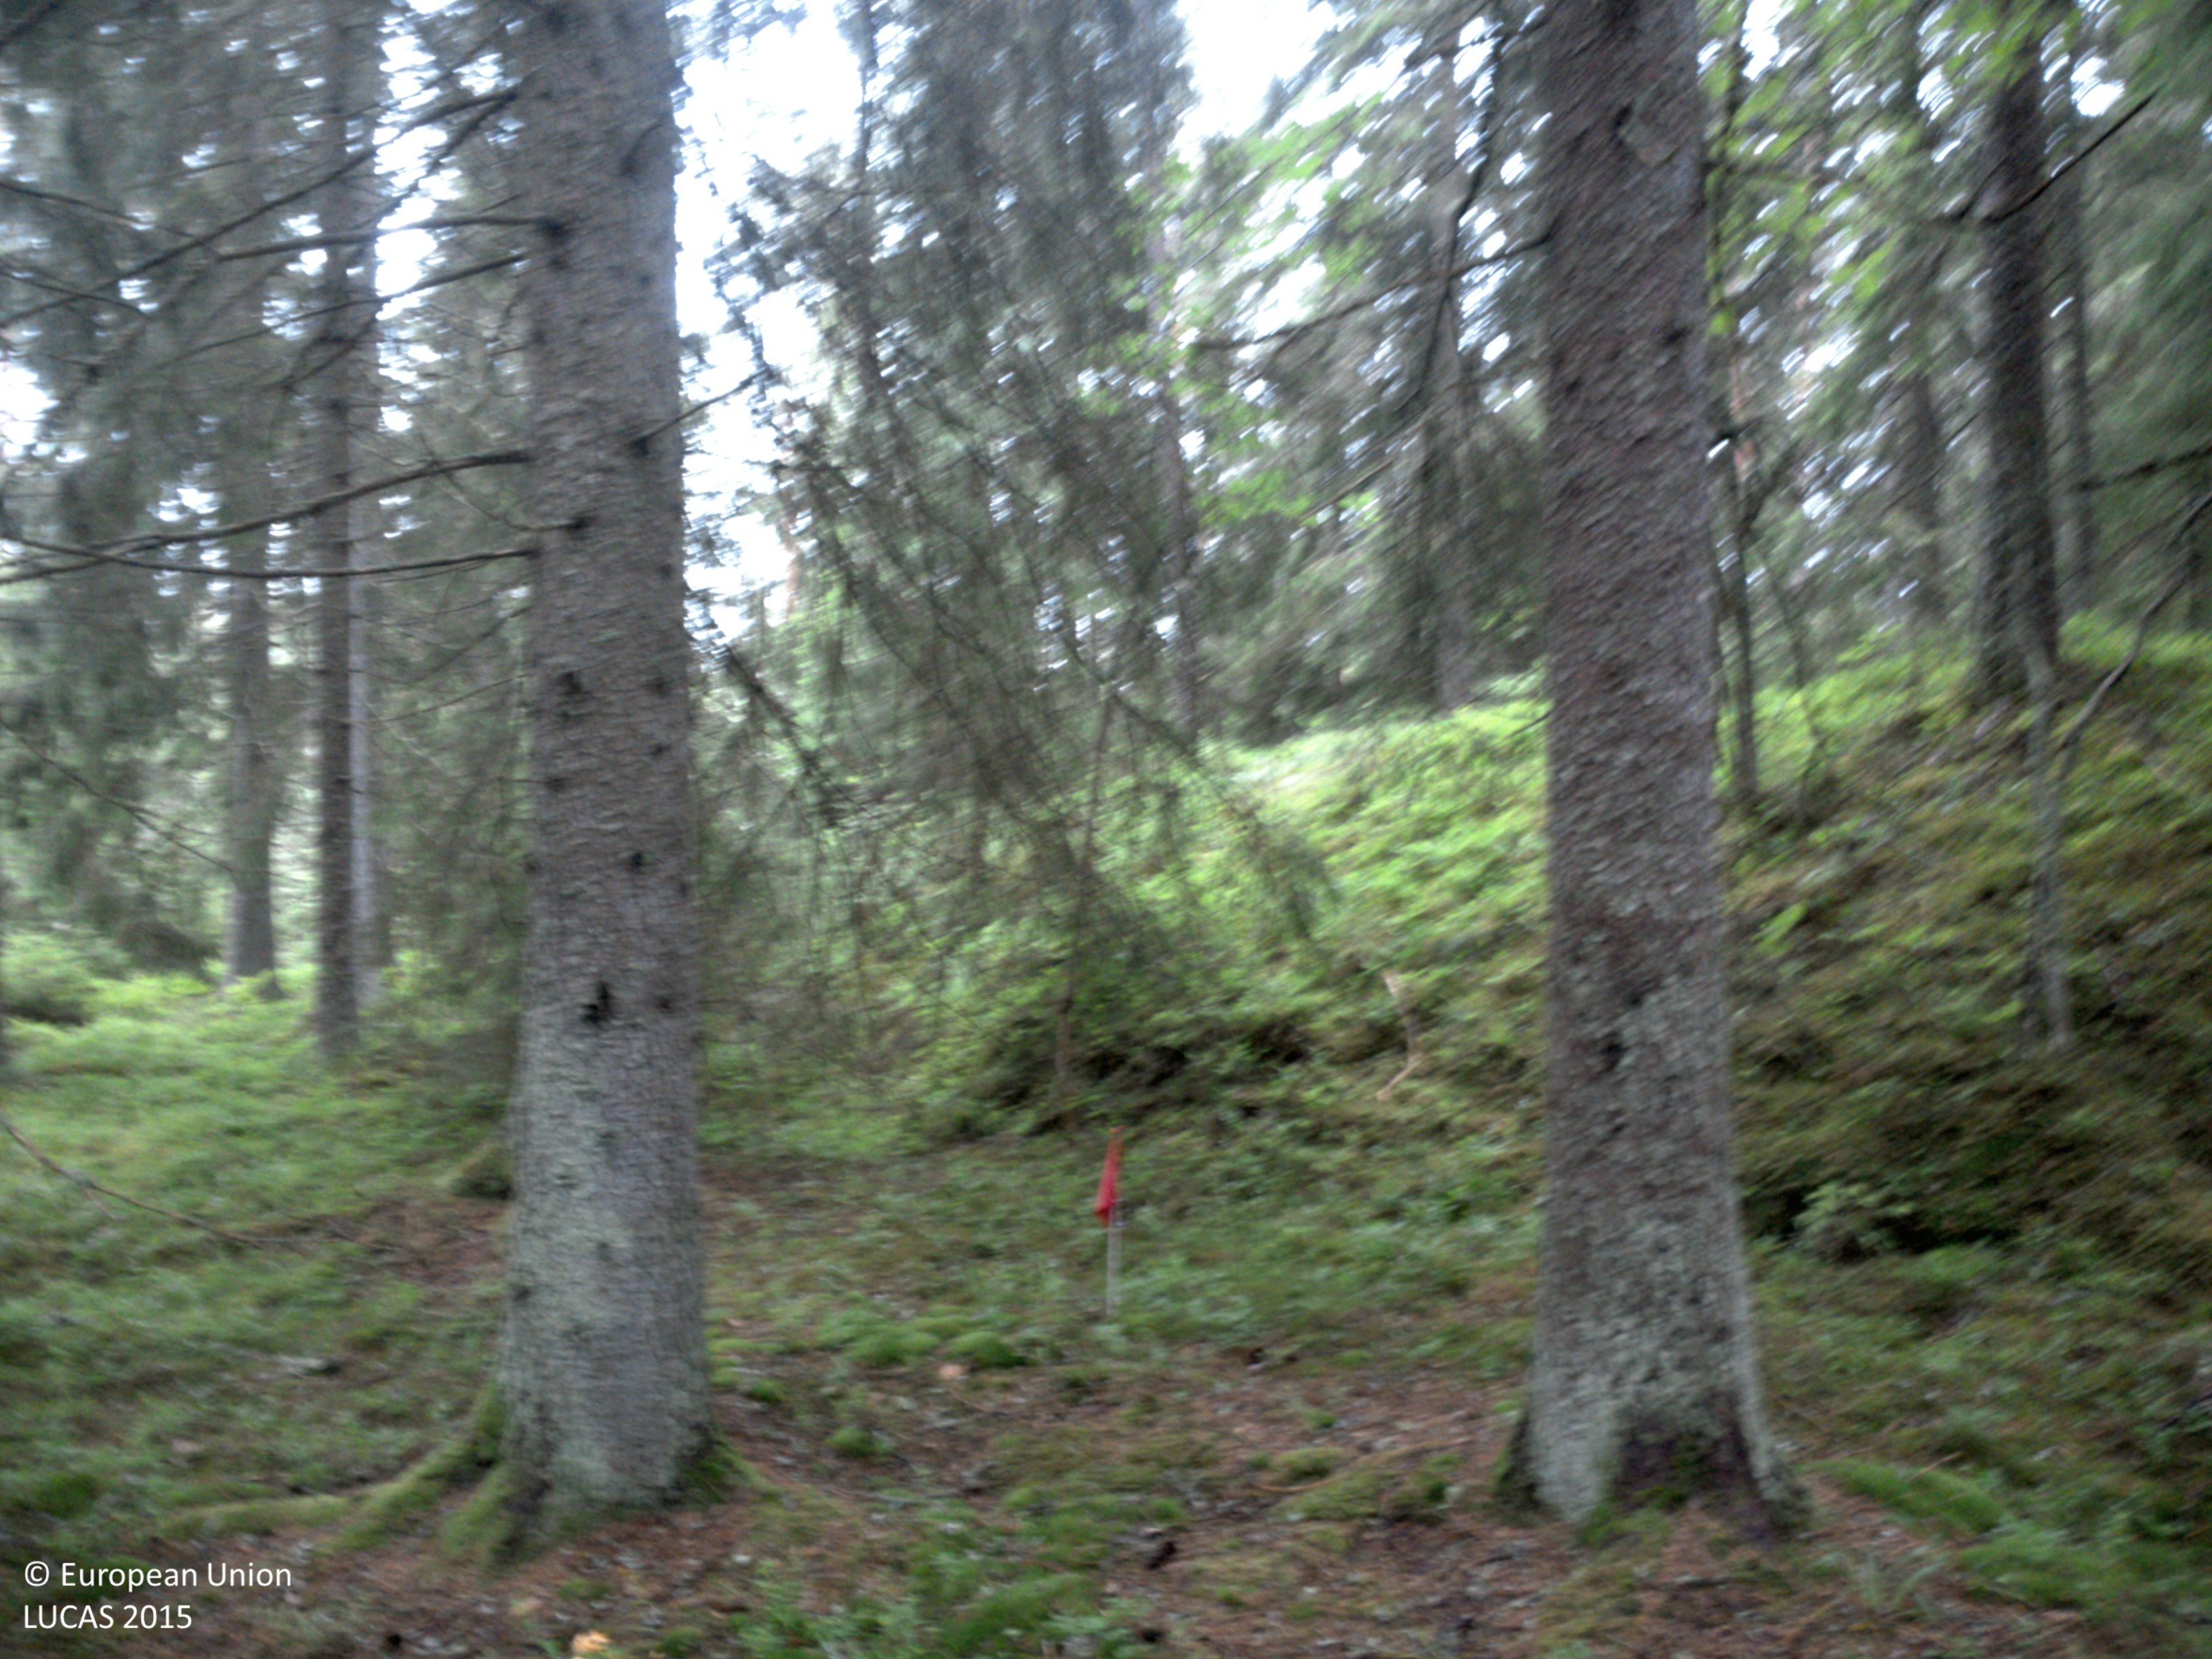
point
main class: Woodland
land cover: Spruce dominated coniferous woodland
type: boreal forest
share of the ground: 50 - 75 %
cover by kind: coniferous forest trees 65 %, lichens and mosses 20 %, herbaceous plants 15 %
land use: Forestry
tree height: > 5 m
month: July
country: SE
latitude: 58.6732
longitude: 11.9444
